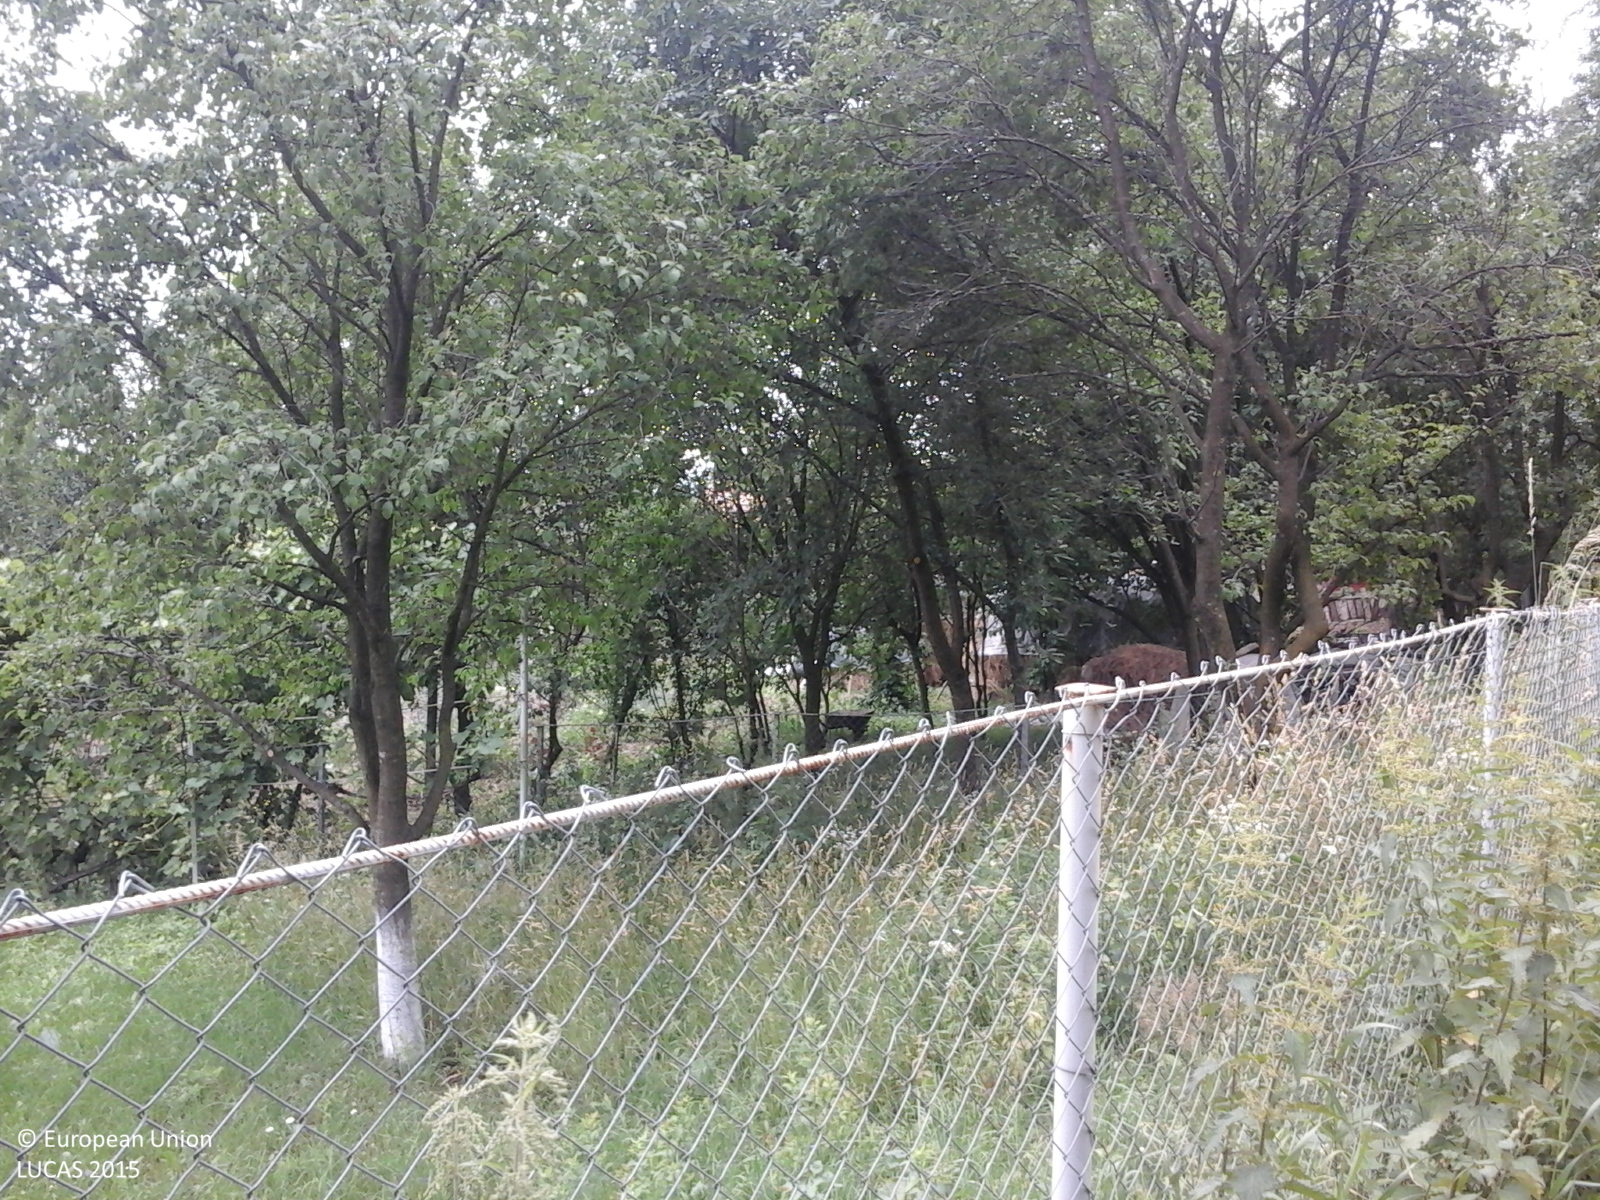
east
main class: Cropland
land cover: Apple fruit
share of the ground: 10 - 25 %
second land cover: Grassland without tree/shrub cover
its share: > 75 %
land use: Agriculture (excluding fallow land and kitchen gardens)
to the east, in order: Apple fruit; Grassland without tree/shrub cover; Artificial constructions in urban areas; Arable land (only in case pi); Artificial constructions in urban areas; Arable land (only in case pi)
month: June
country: RO
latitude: 47.5721
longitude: 26.3975
